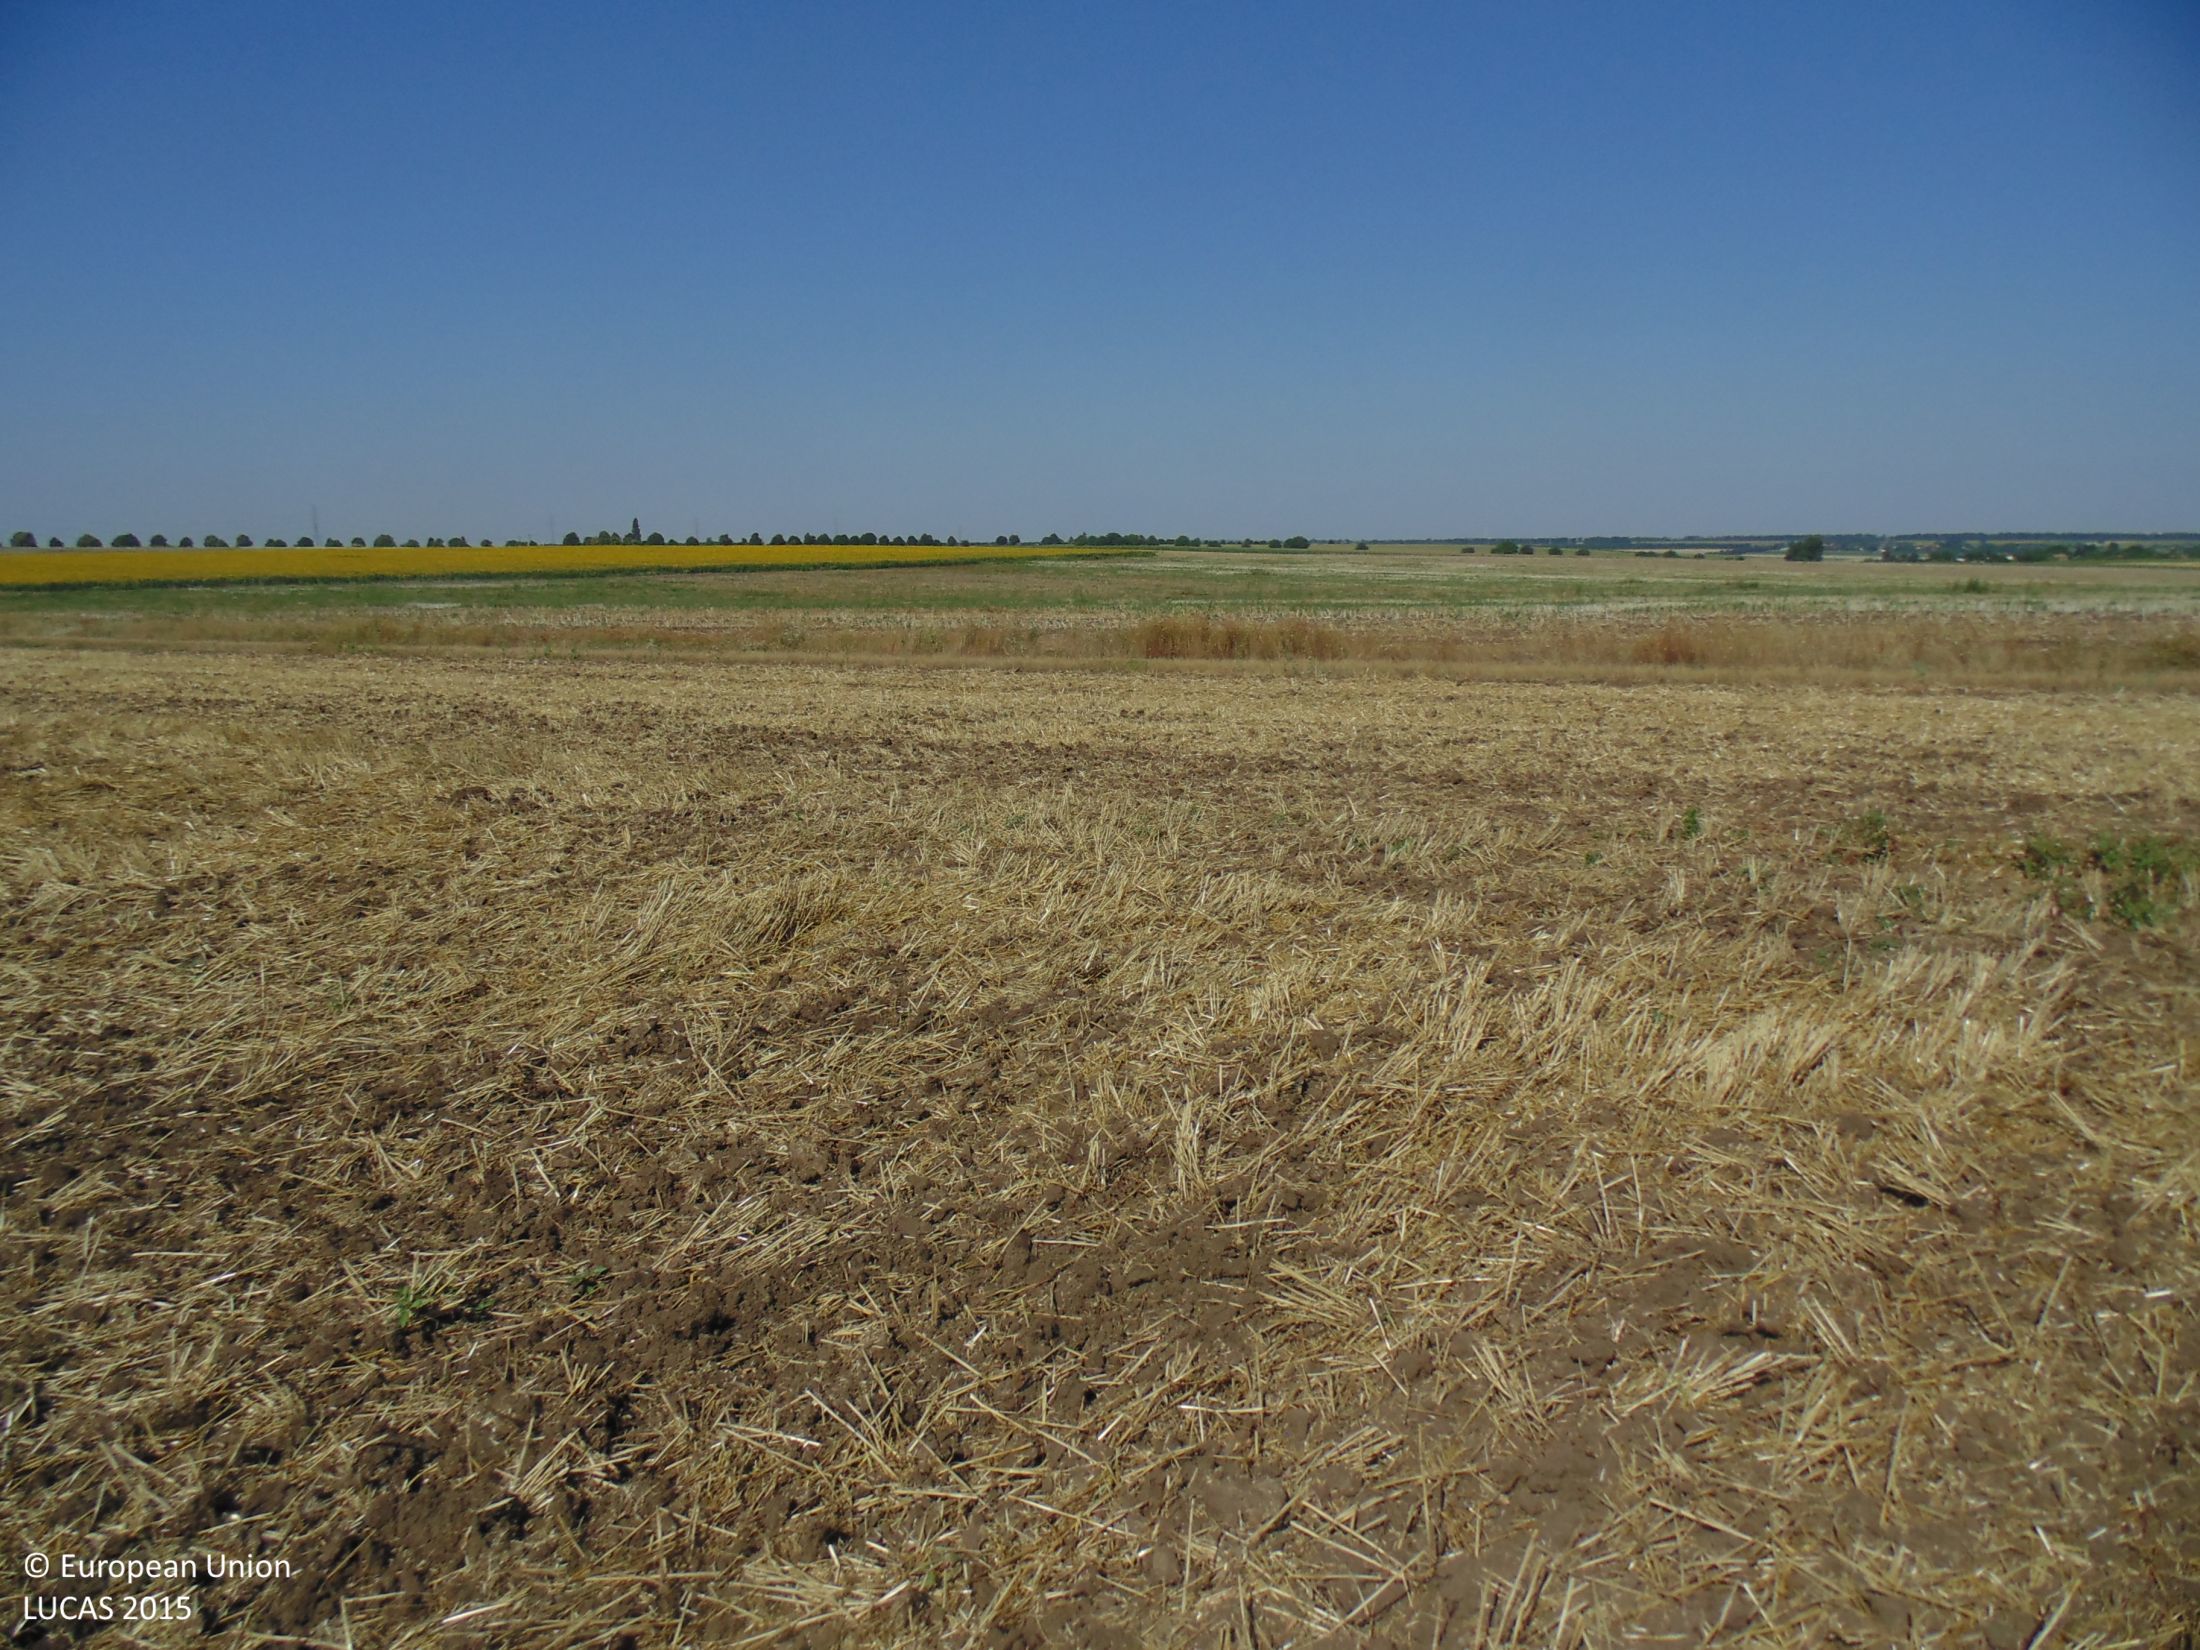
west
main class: Cropland
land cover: Common wheat
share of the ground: 10 - 25 %
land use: Agriculture (excluding fallow land and kitchen gardens)
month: July
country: BG
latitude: 43.5434
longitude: 27.9543
